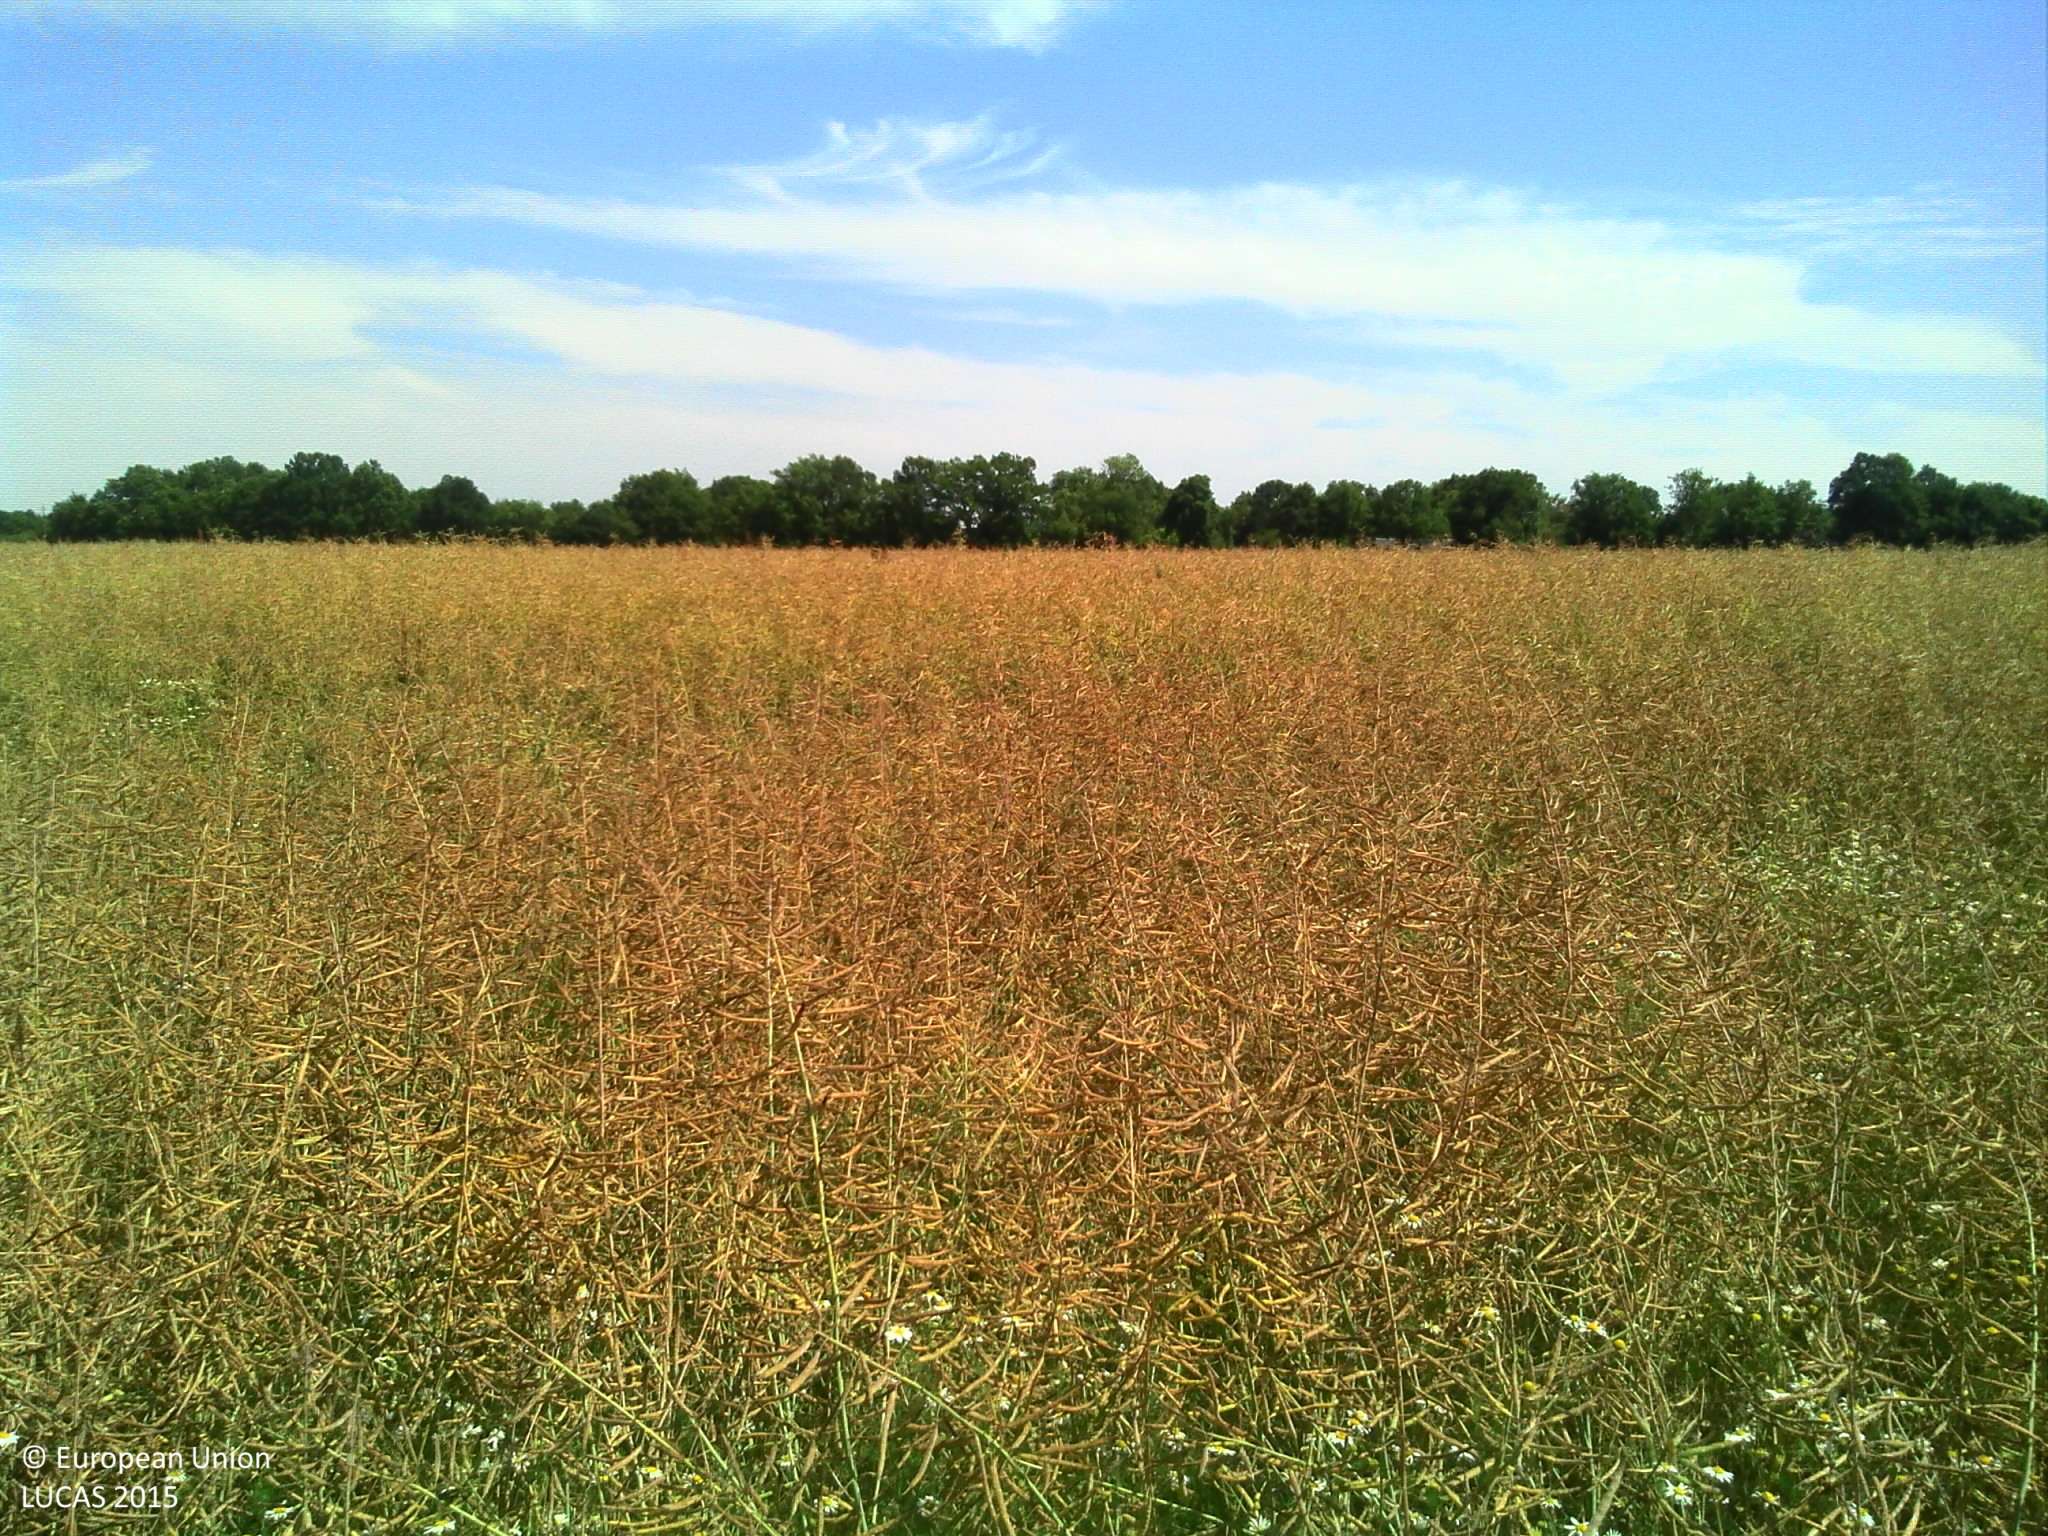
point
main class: Cropland
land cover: Rape and turnip rape
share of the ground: > 75 %
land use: Agriculture (excluding fallow land and kitchen gardens)
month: June
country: FR
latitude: 47.5905
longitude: 2.5317
